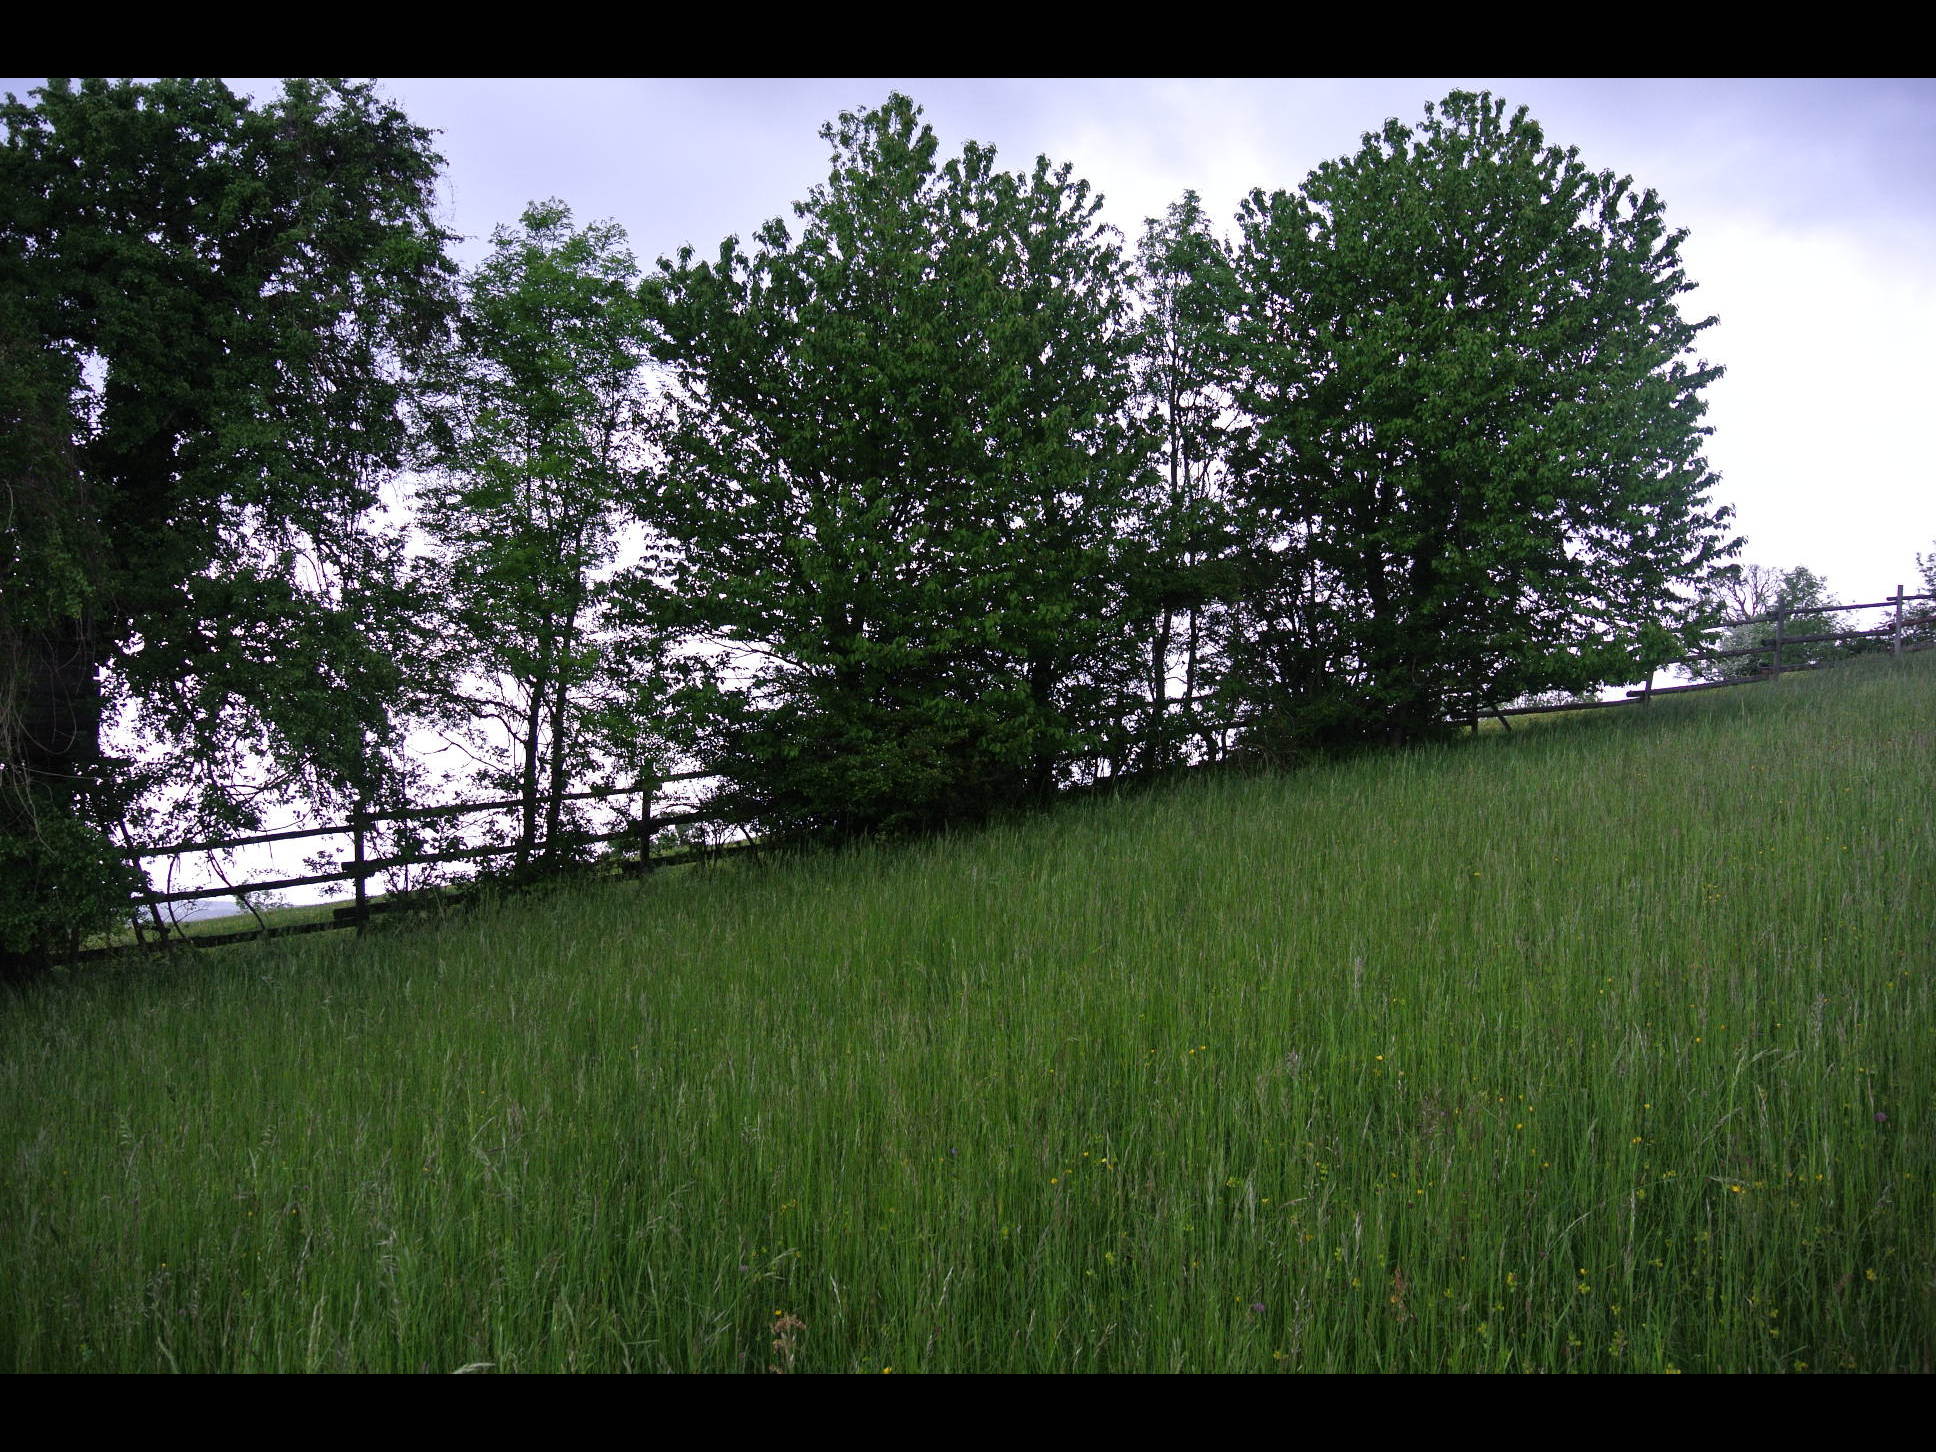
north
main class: Grassland
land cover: Grassland without tree/shrub cover
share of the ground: > 75 %
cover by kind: herbaceous plants 100 %
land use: Agriculture (excluding fallow land and kitchen gardens)
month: May
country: AT
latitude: 48.1225
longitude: 15.8470
